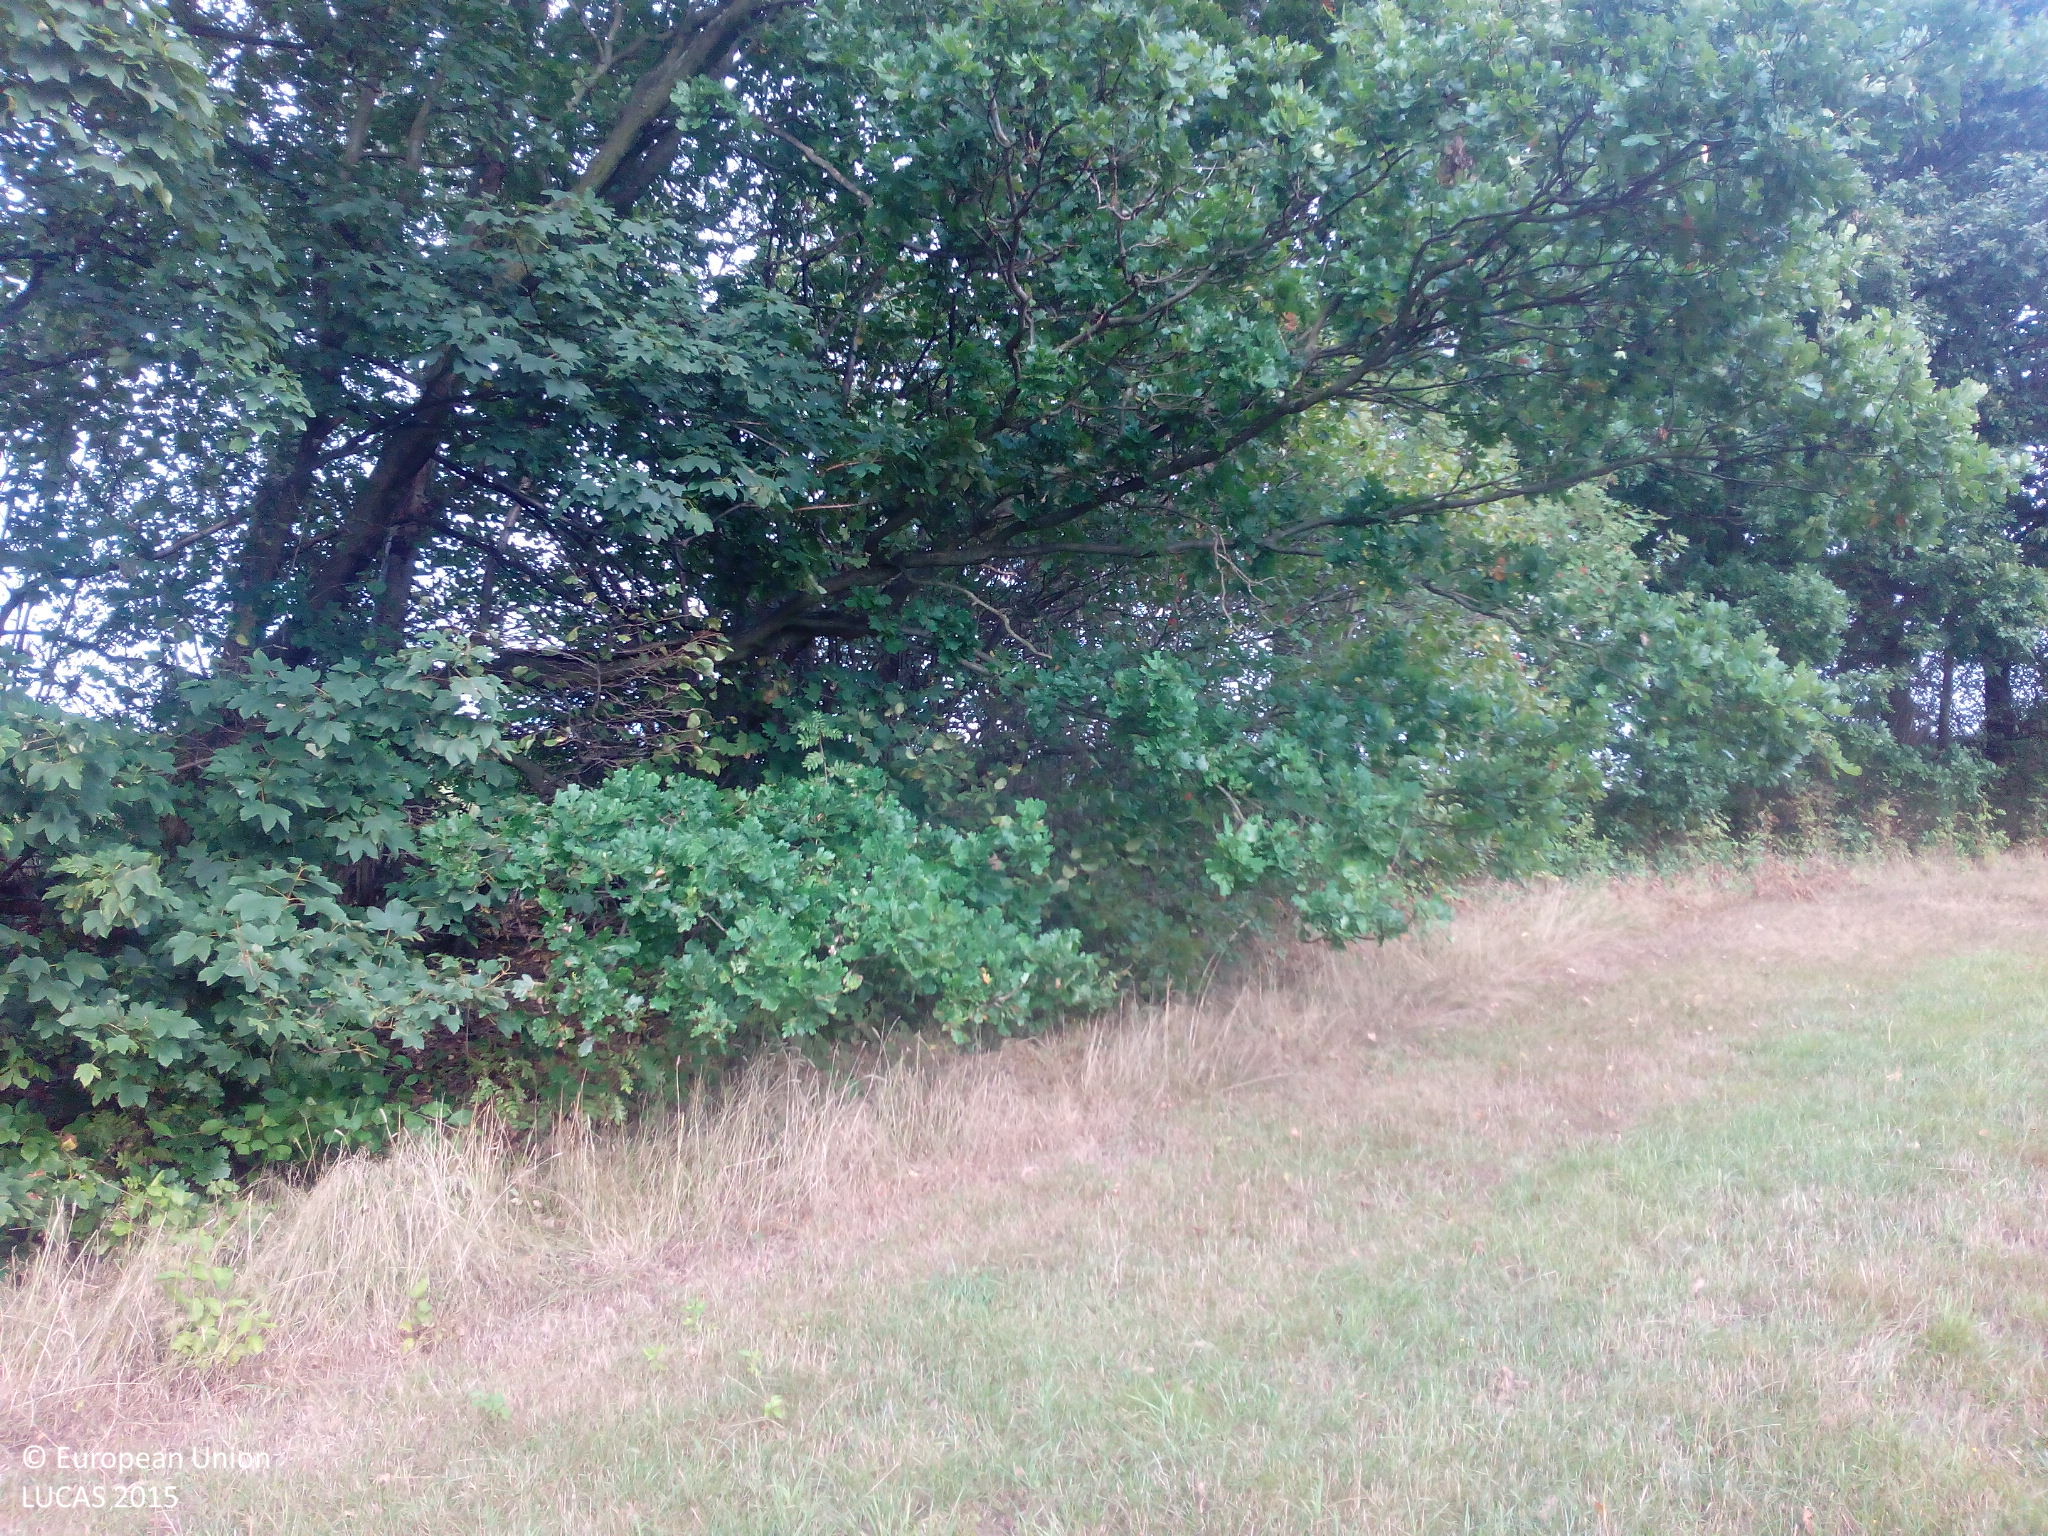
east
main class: Grassland
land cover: Grassland without tree/shrub cover
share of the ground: > 75 %
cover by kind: herbaceous plants 100 %
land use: Agriculture (excluding fallow land and kitchen gardens)
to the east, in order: Grassland without tree/shrub cover; Broadleaved woodland; Grassland without tree/shrub cover; Tracks; Grassland without tree/shrub cover; Broadleaved woodland; Grassland without tree/shrub cover
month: August
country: DE
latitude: 50.8345
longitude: 13.9910
